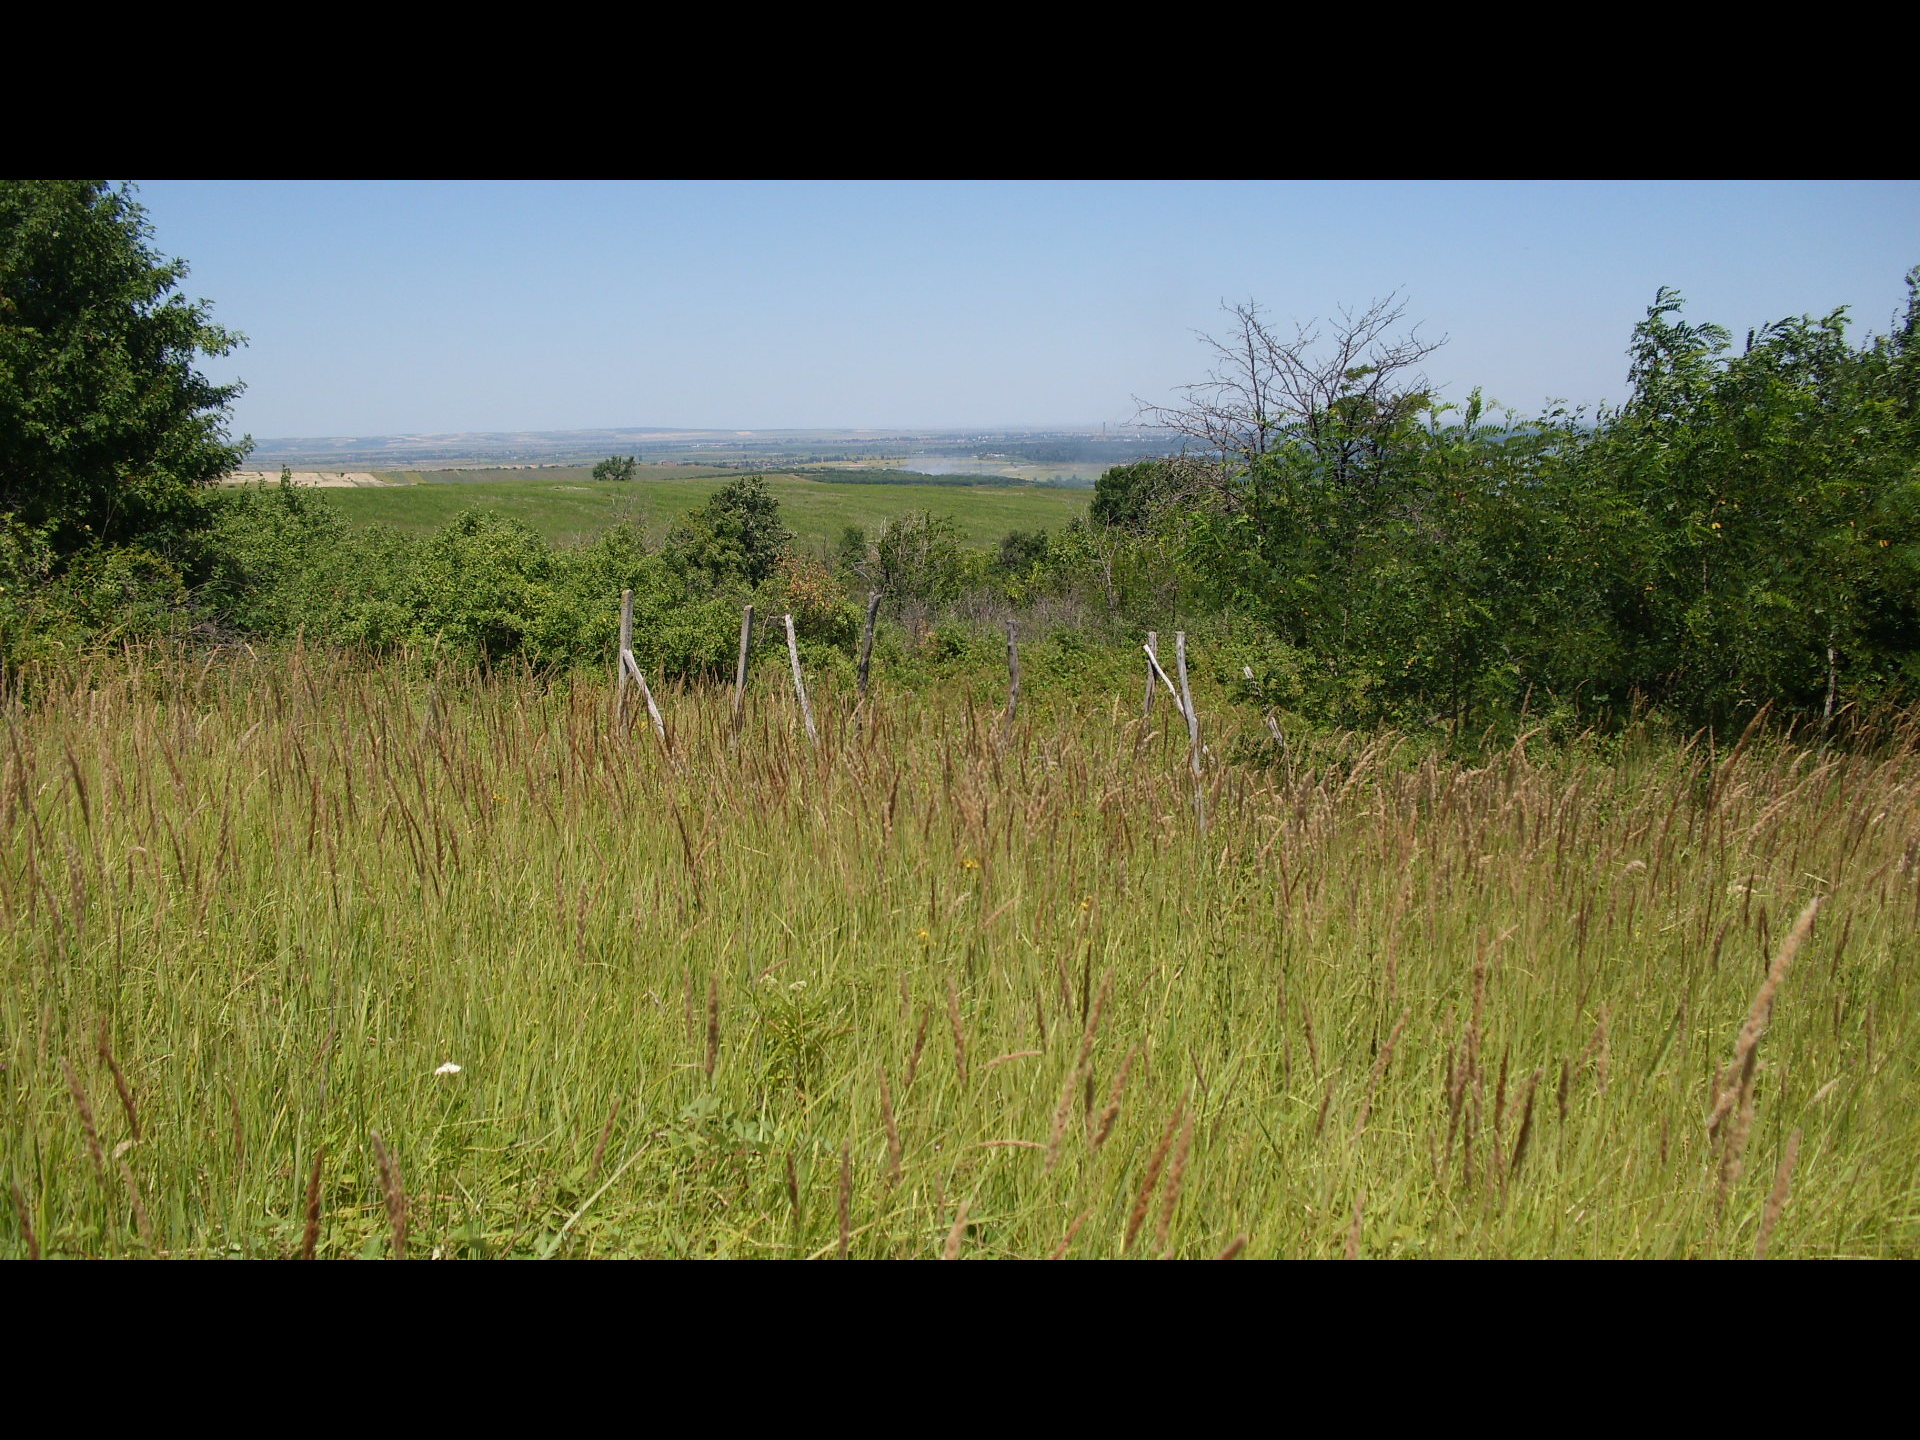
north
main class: Grassland
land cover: Grassland without tree/shrub cover
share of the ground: > 75 %
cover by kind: herbaceous plants 100 %
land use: Agriculture (excluding fallow land and kitchen gardens)
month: July
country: BG
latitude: 43.8624
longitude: 22.8158
